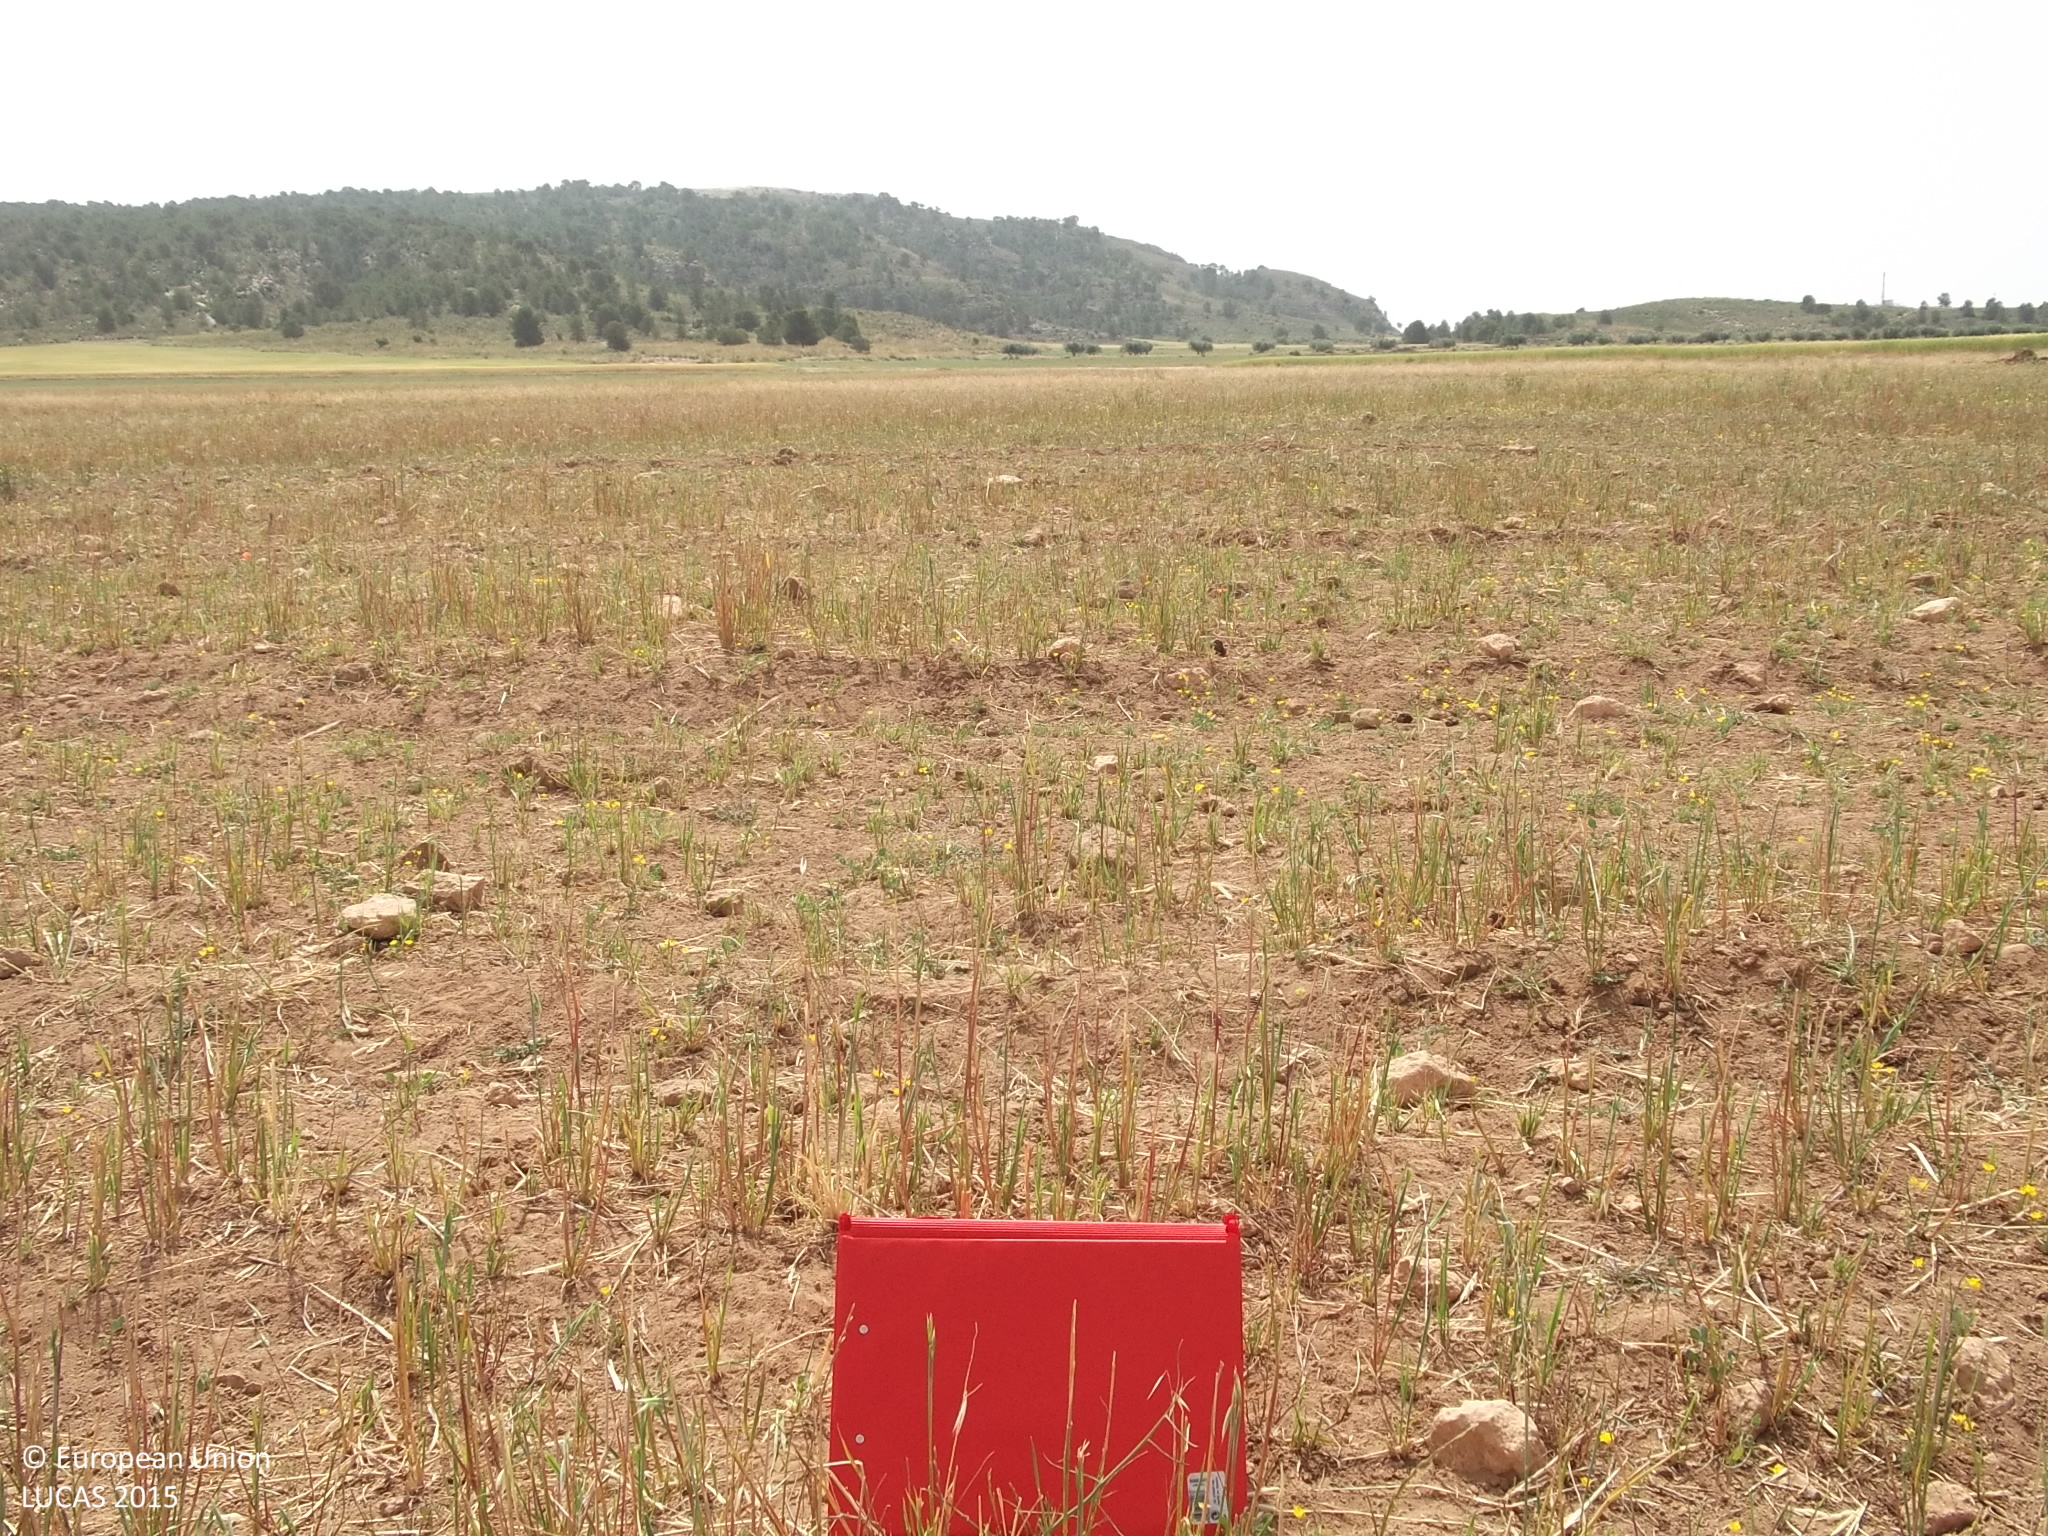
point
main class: Grassland
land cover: Spontaneously vegetated surfaces
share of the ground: 50 - 75 %
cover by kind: herbaceous plants 50 %, unconsolidated bare surface 50 %
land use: Fallow land
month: May
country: ES
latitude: 38.4564
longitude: -1.6466
